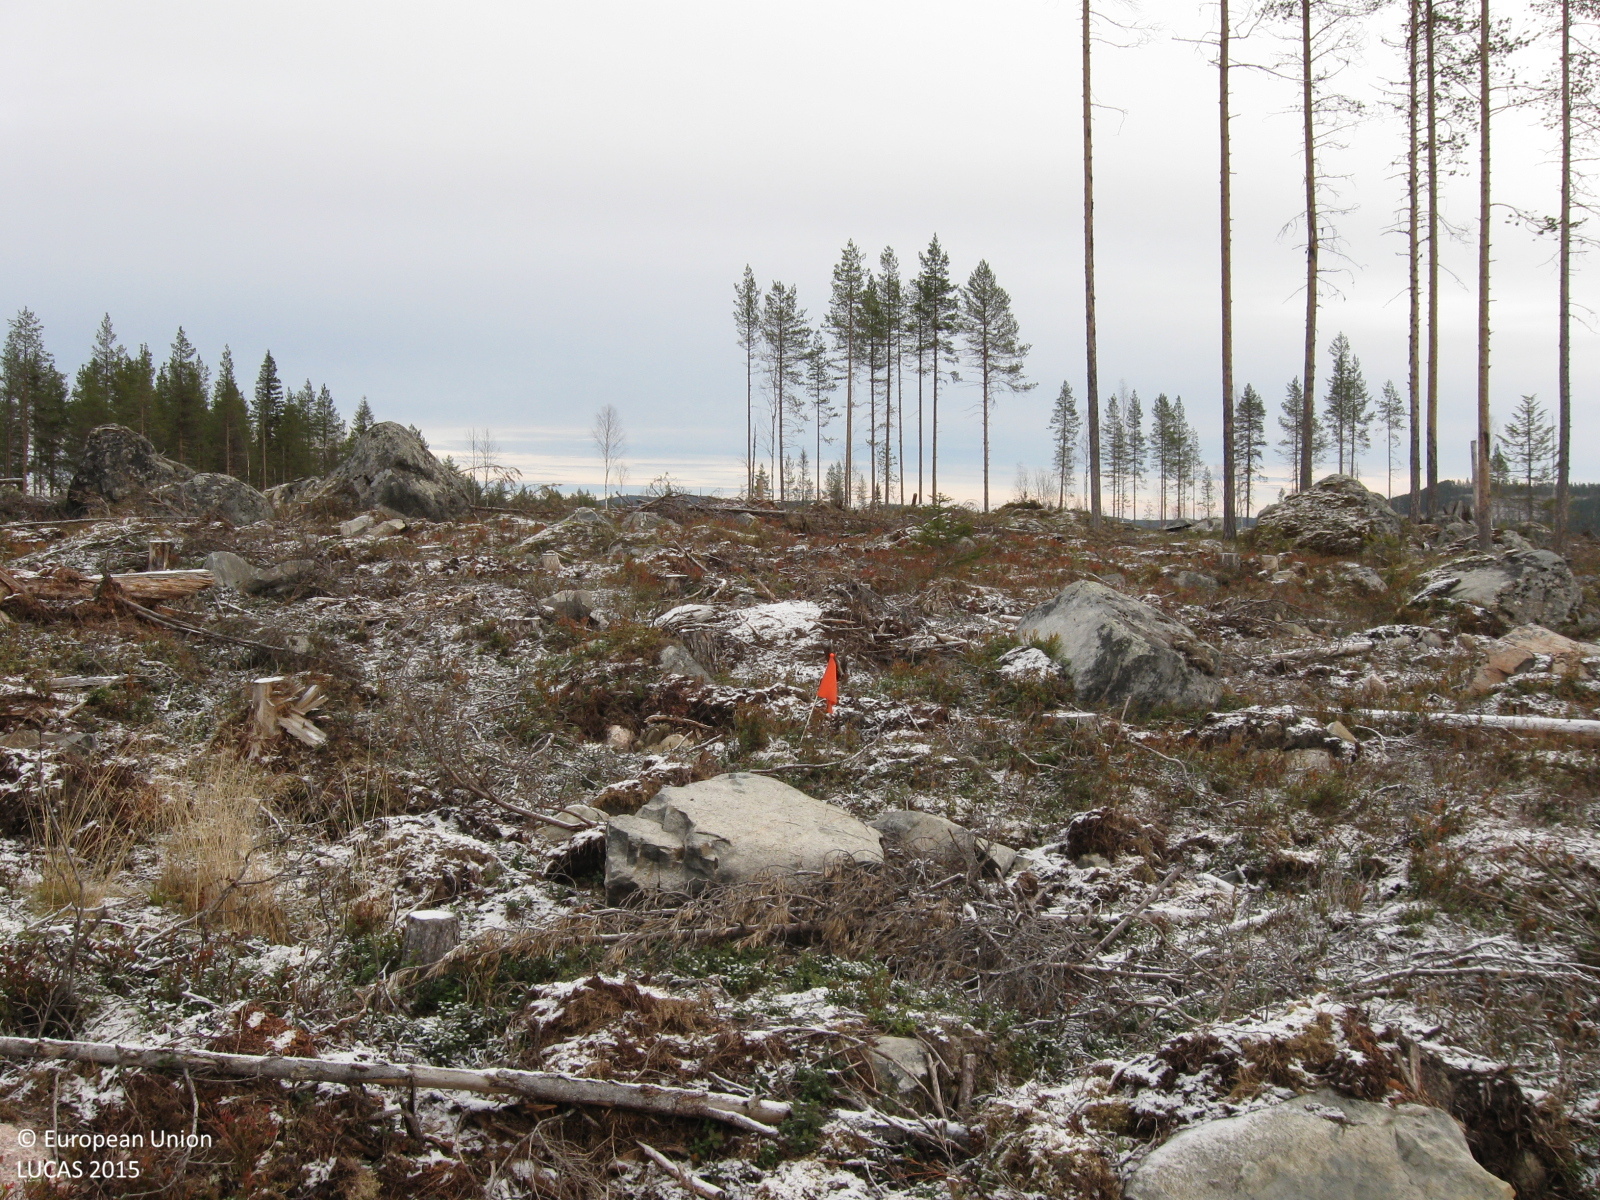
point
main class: Shrubland
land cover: Shrubland with sparse tree cover
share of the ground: 25 - 50 %
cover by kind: shrubs 45 %, consolidated bare surface 15 %, herbaceous plants 10 %, lichens and mosses 10 %, coniferous forest trees 5 %, unconsolidated bare surface 5 %
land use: Forestry
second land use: Amenities, museums, leisure
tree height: < 5 m
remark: Clear cut
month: October
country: SE
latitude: 66.2125
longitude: 21.4973
